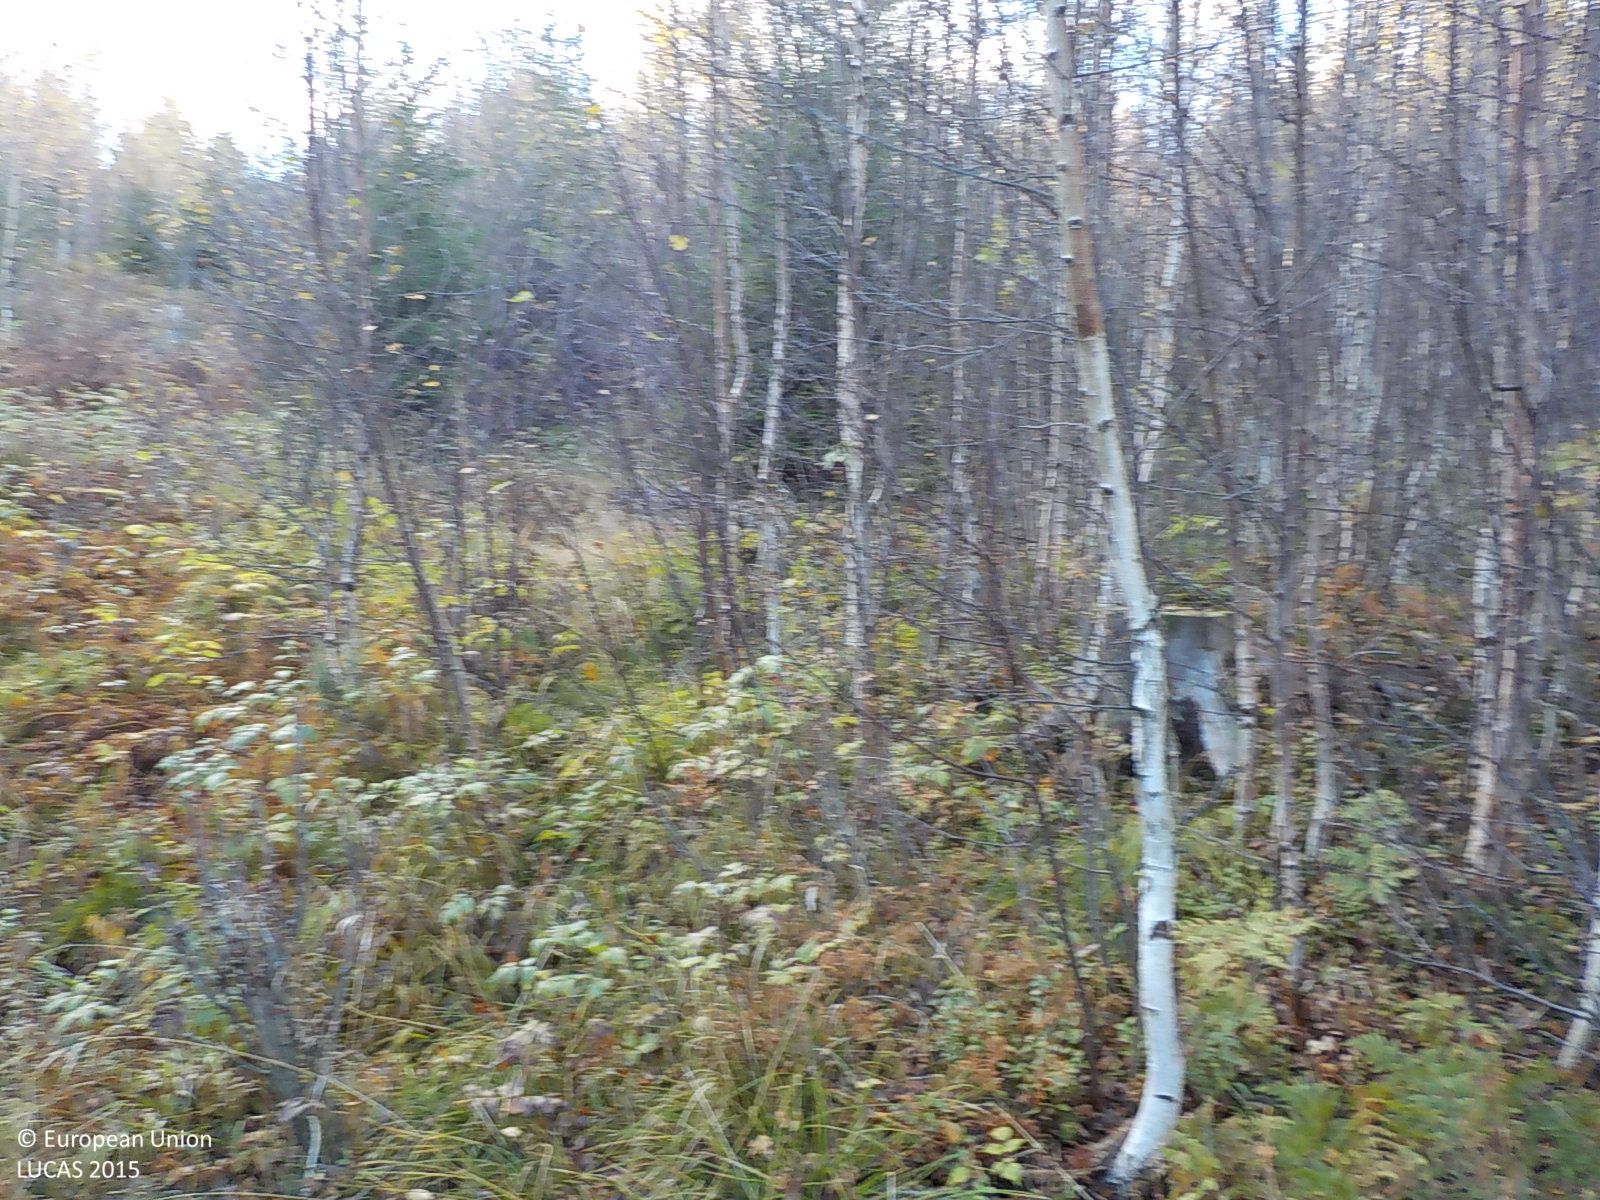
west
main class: Woodland
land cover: Broadleaved woodland
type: mire and swamp forests
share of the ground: 50 - 75 %
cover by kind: broadleaved forest trees 65 %, herbaceous plants 20 %, coniferous forest trees 10 %, lichens and mosses 5 %
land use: Forestry
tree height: > 5 m
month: October
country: SE
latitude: 62.9670
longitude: 18.2423
